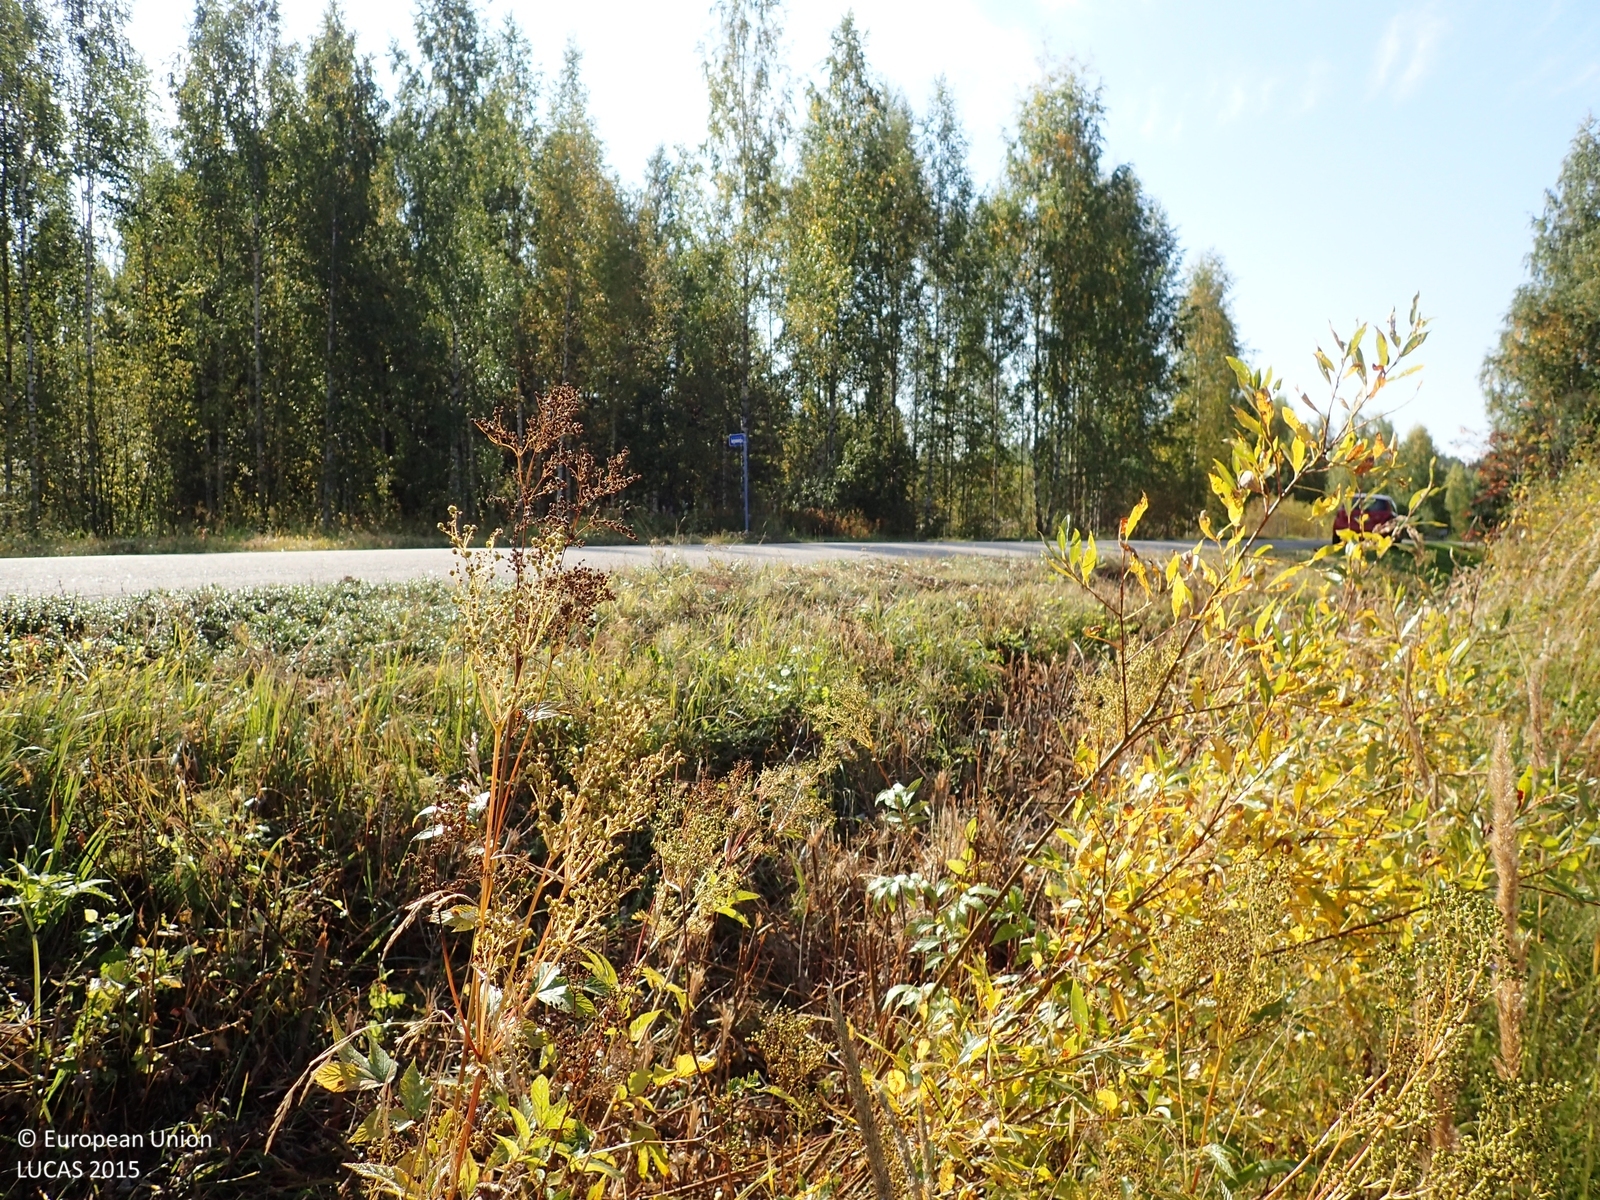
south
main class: Cropland
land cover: Barley
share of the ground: > 75 %
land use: Agriculture (excluding fallow land and kitchen gardens)
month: September
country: FI
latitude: 62.9775
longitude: 25.5557
